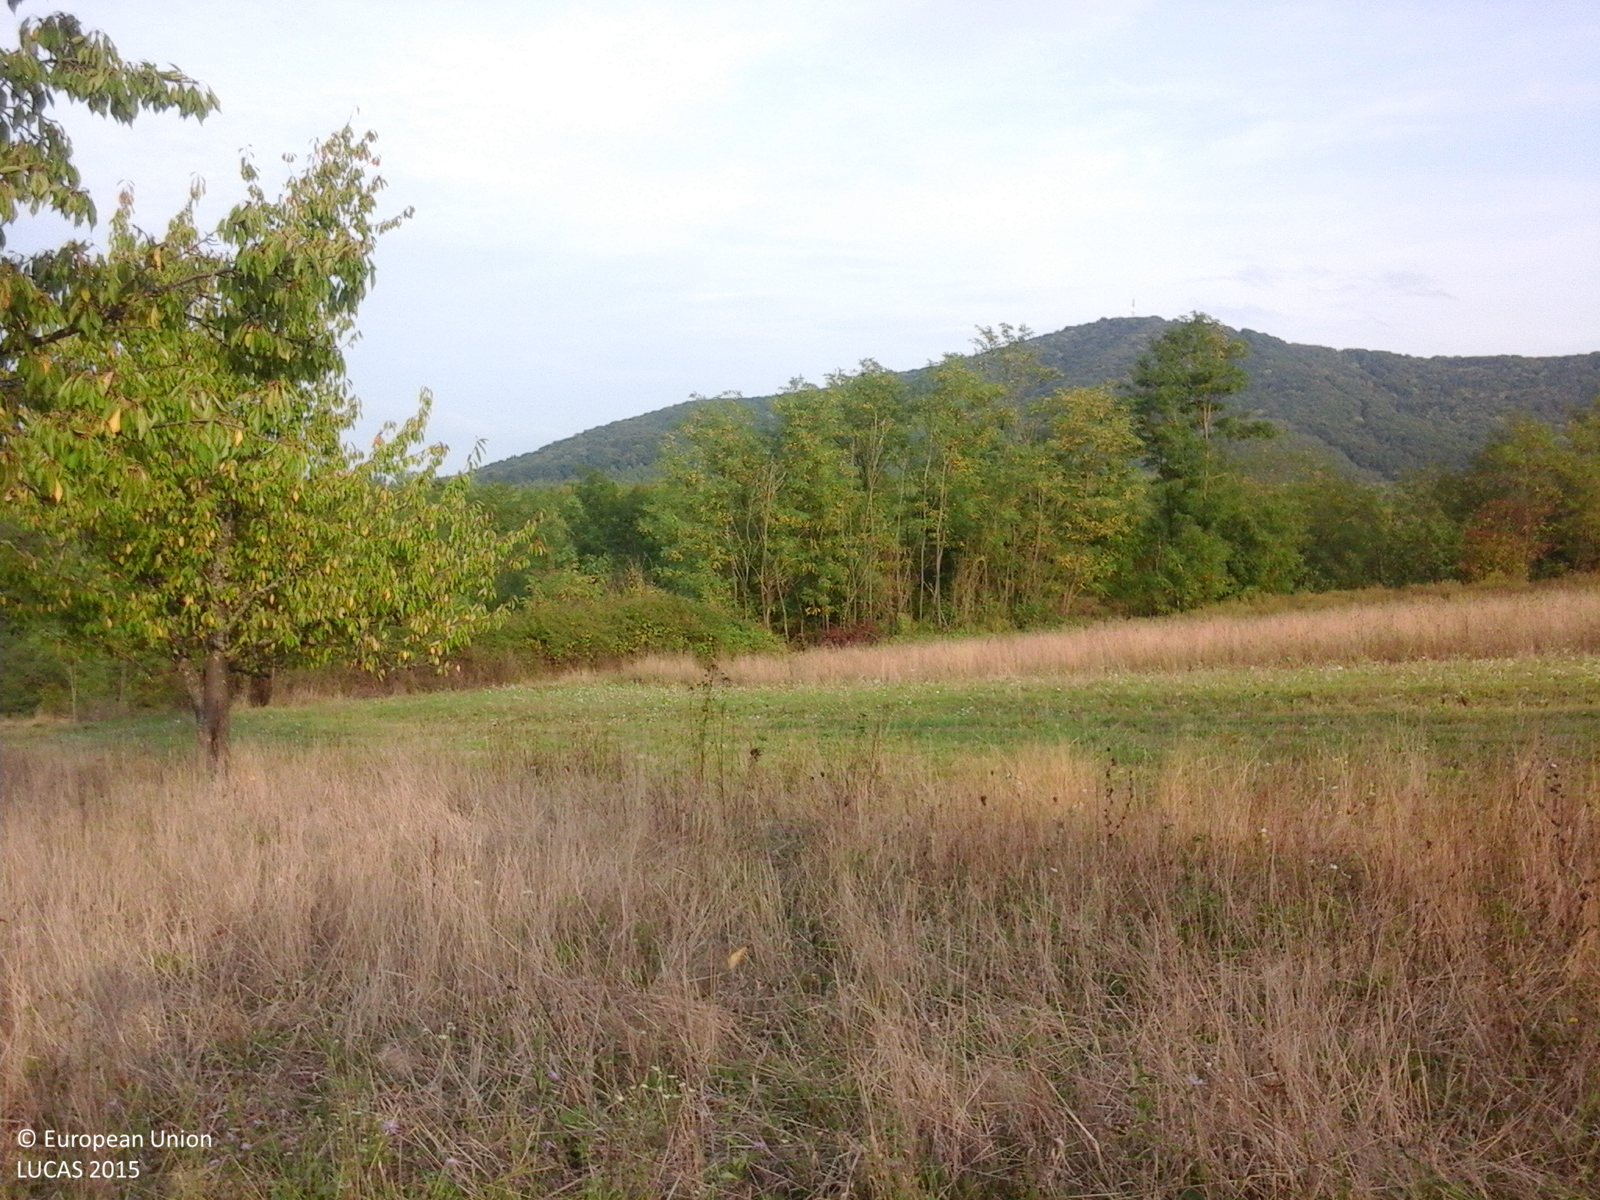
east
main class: Cropland
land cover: Other fruit trees and berries
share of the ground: > 75 %
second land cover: Spontaneously vegetated surfaces
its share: > 75 %
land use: Agriculture (excluding fallow land and kitchen gardens)
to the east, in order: Other fruit trees and berries; Spontaneously vegetated surfaces; Grassland without tree/shrub cover; Tracks; Broadleaved woodland; Tracks; Grassland with sparse tree/shrub cover; Broadleaved woodland
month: September
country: RO
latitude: 45.7540
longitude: 22.0869
